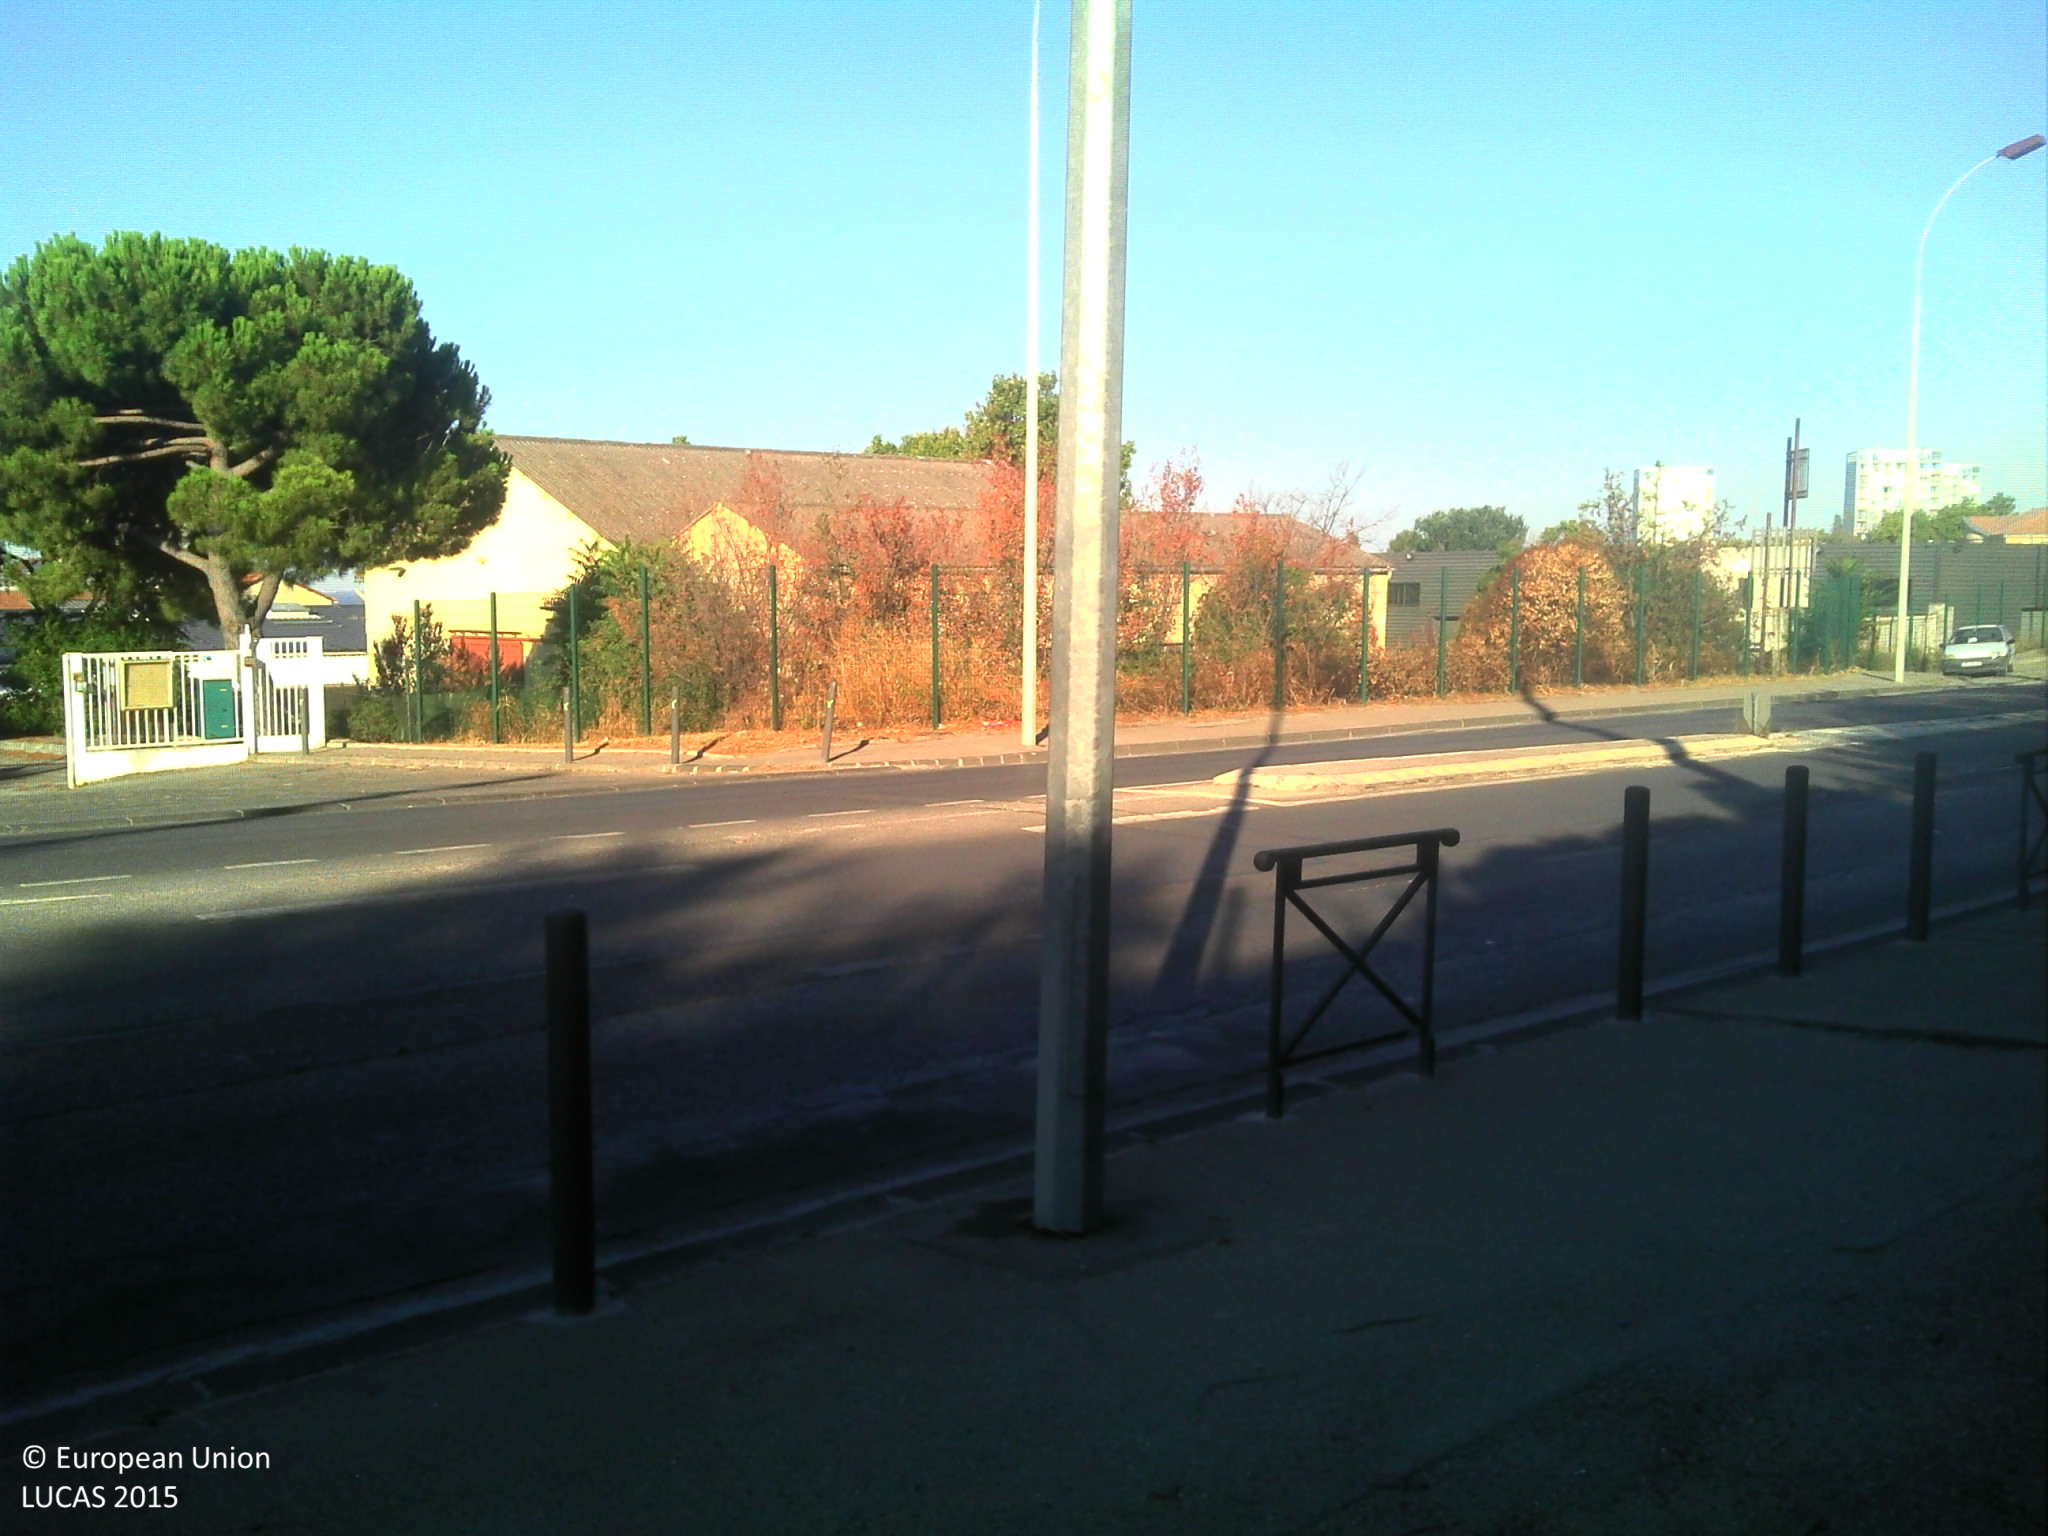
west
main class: Grassland
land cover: Spontaneously vegetated surfaces
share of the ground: > 75 %
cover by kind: consolidated bare surface 70 %, herbaceous plants 30 %
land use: Railway transport
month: August
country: FR
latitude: 43.3444
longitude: 5.3843
